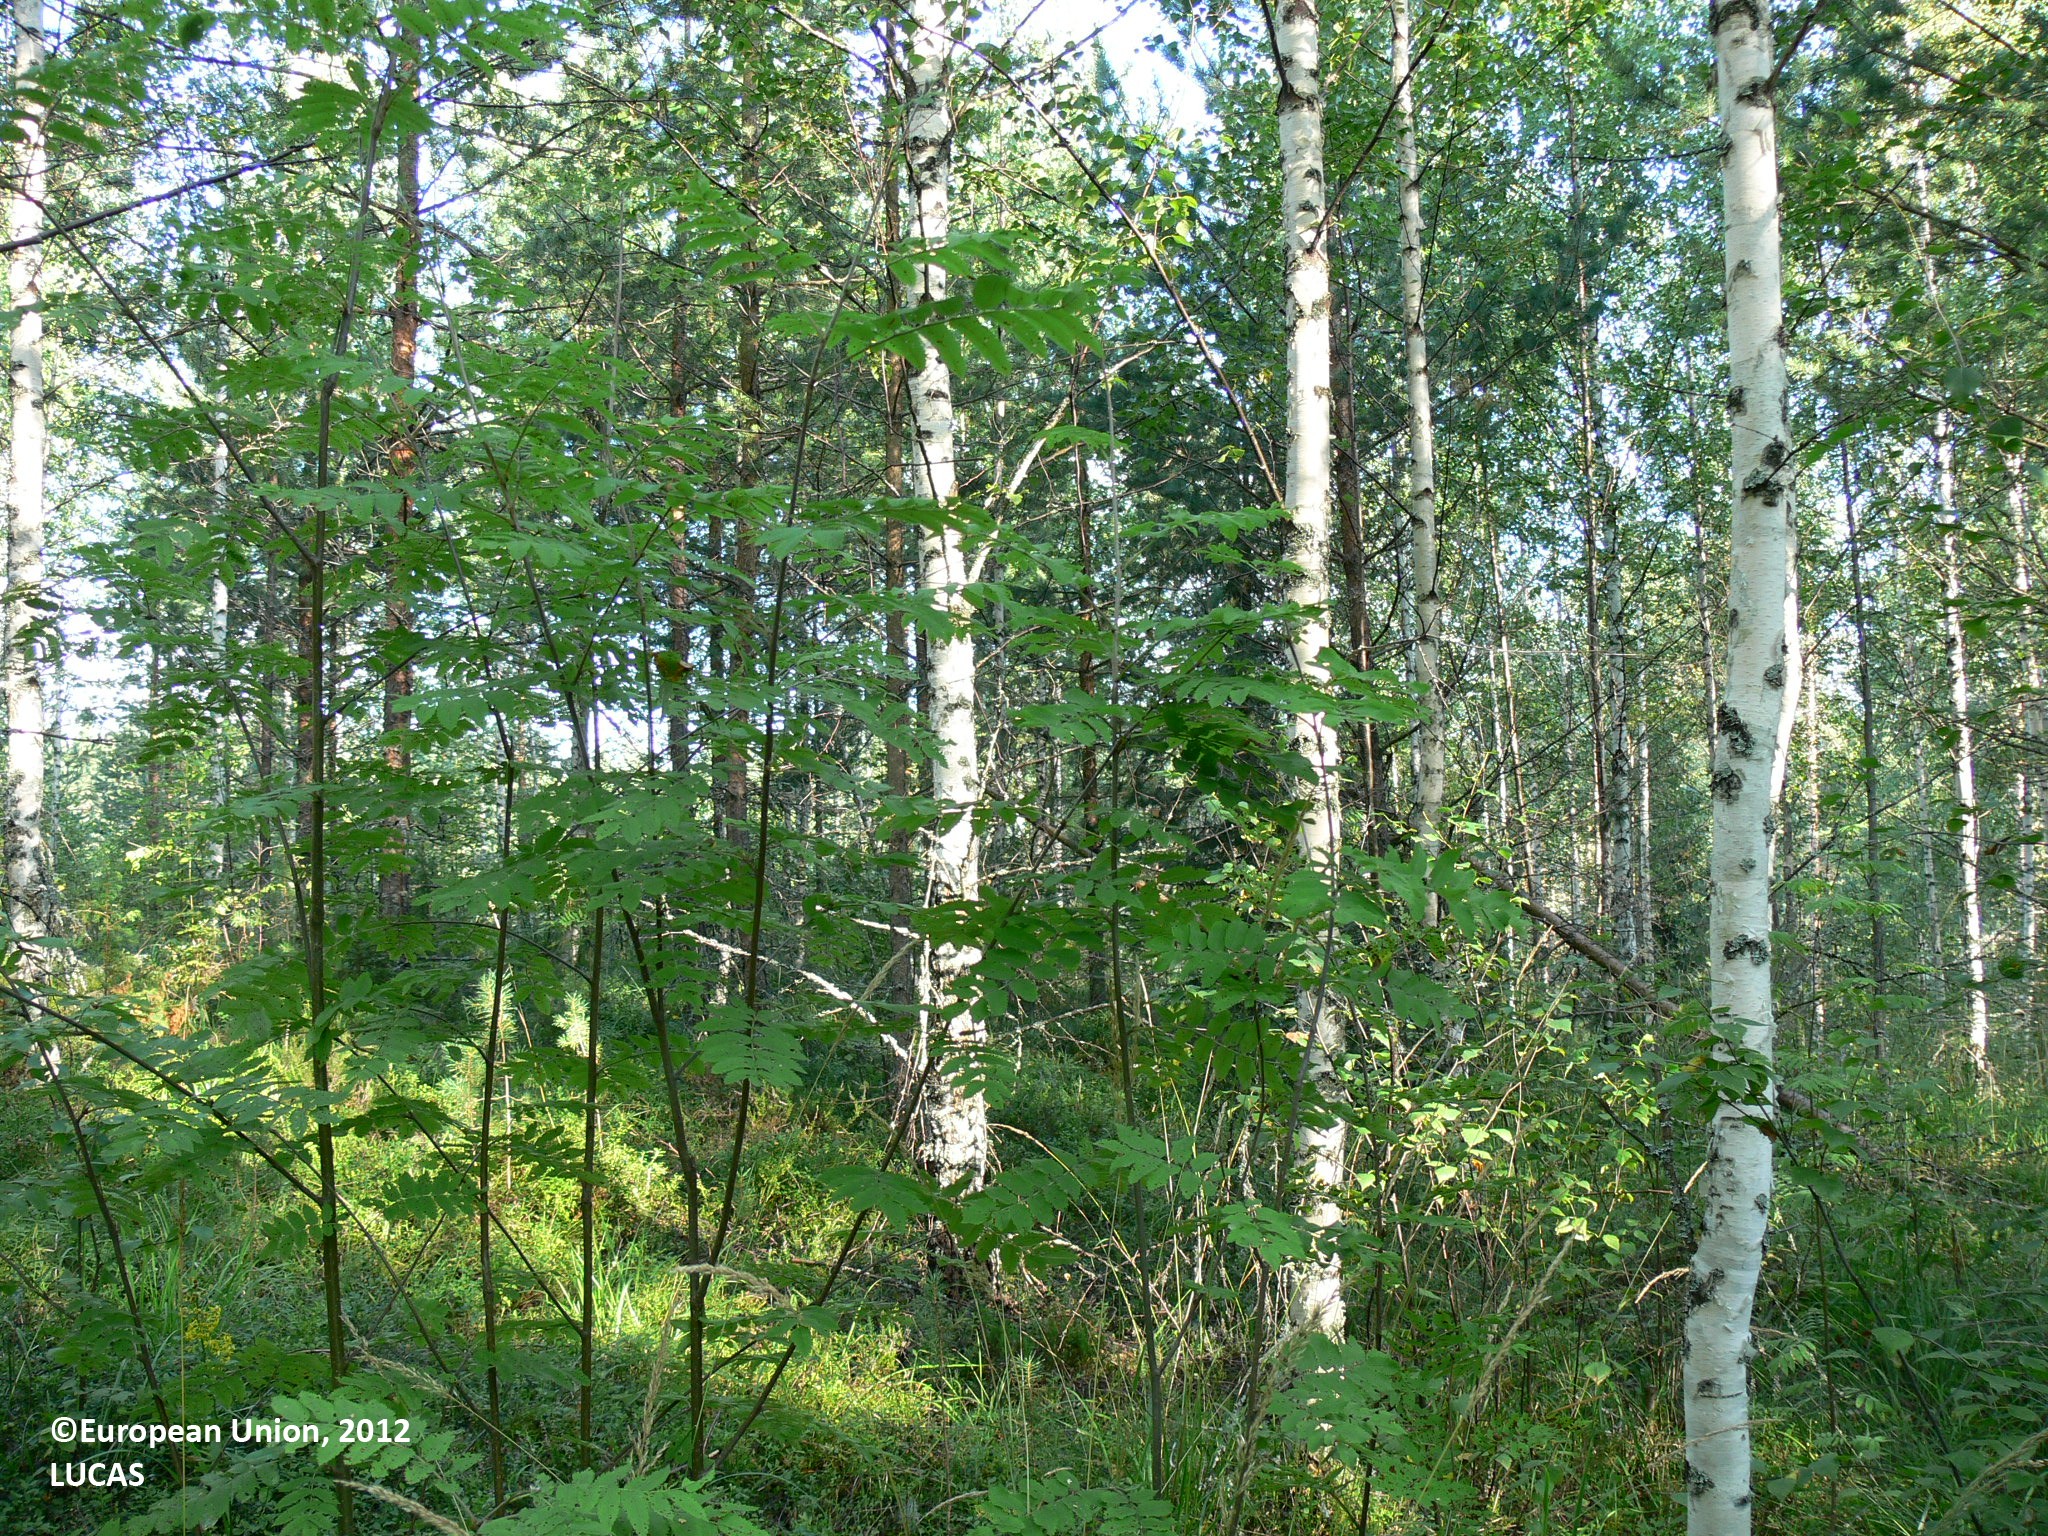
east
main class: Woodland
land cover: Broadleaved woodland
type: boreal forest
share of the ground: > 75 %
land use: Forestry
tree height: > 5 m
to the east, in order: Broadleaved woodland; Pine dominated mixed woodland; Other mixed woodland; Pine dominated mixed woodland; Pine dominated coniferous woodland
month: August
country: FI
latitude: 61.8715
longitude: 29.9446
